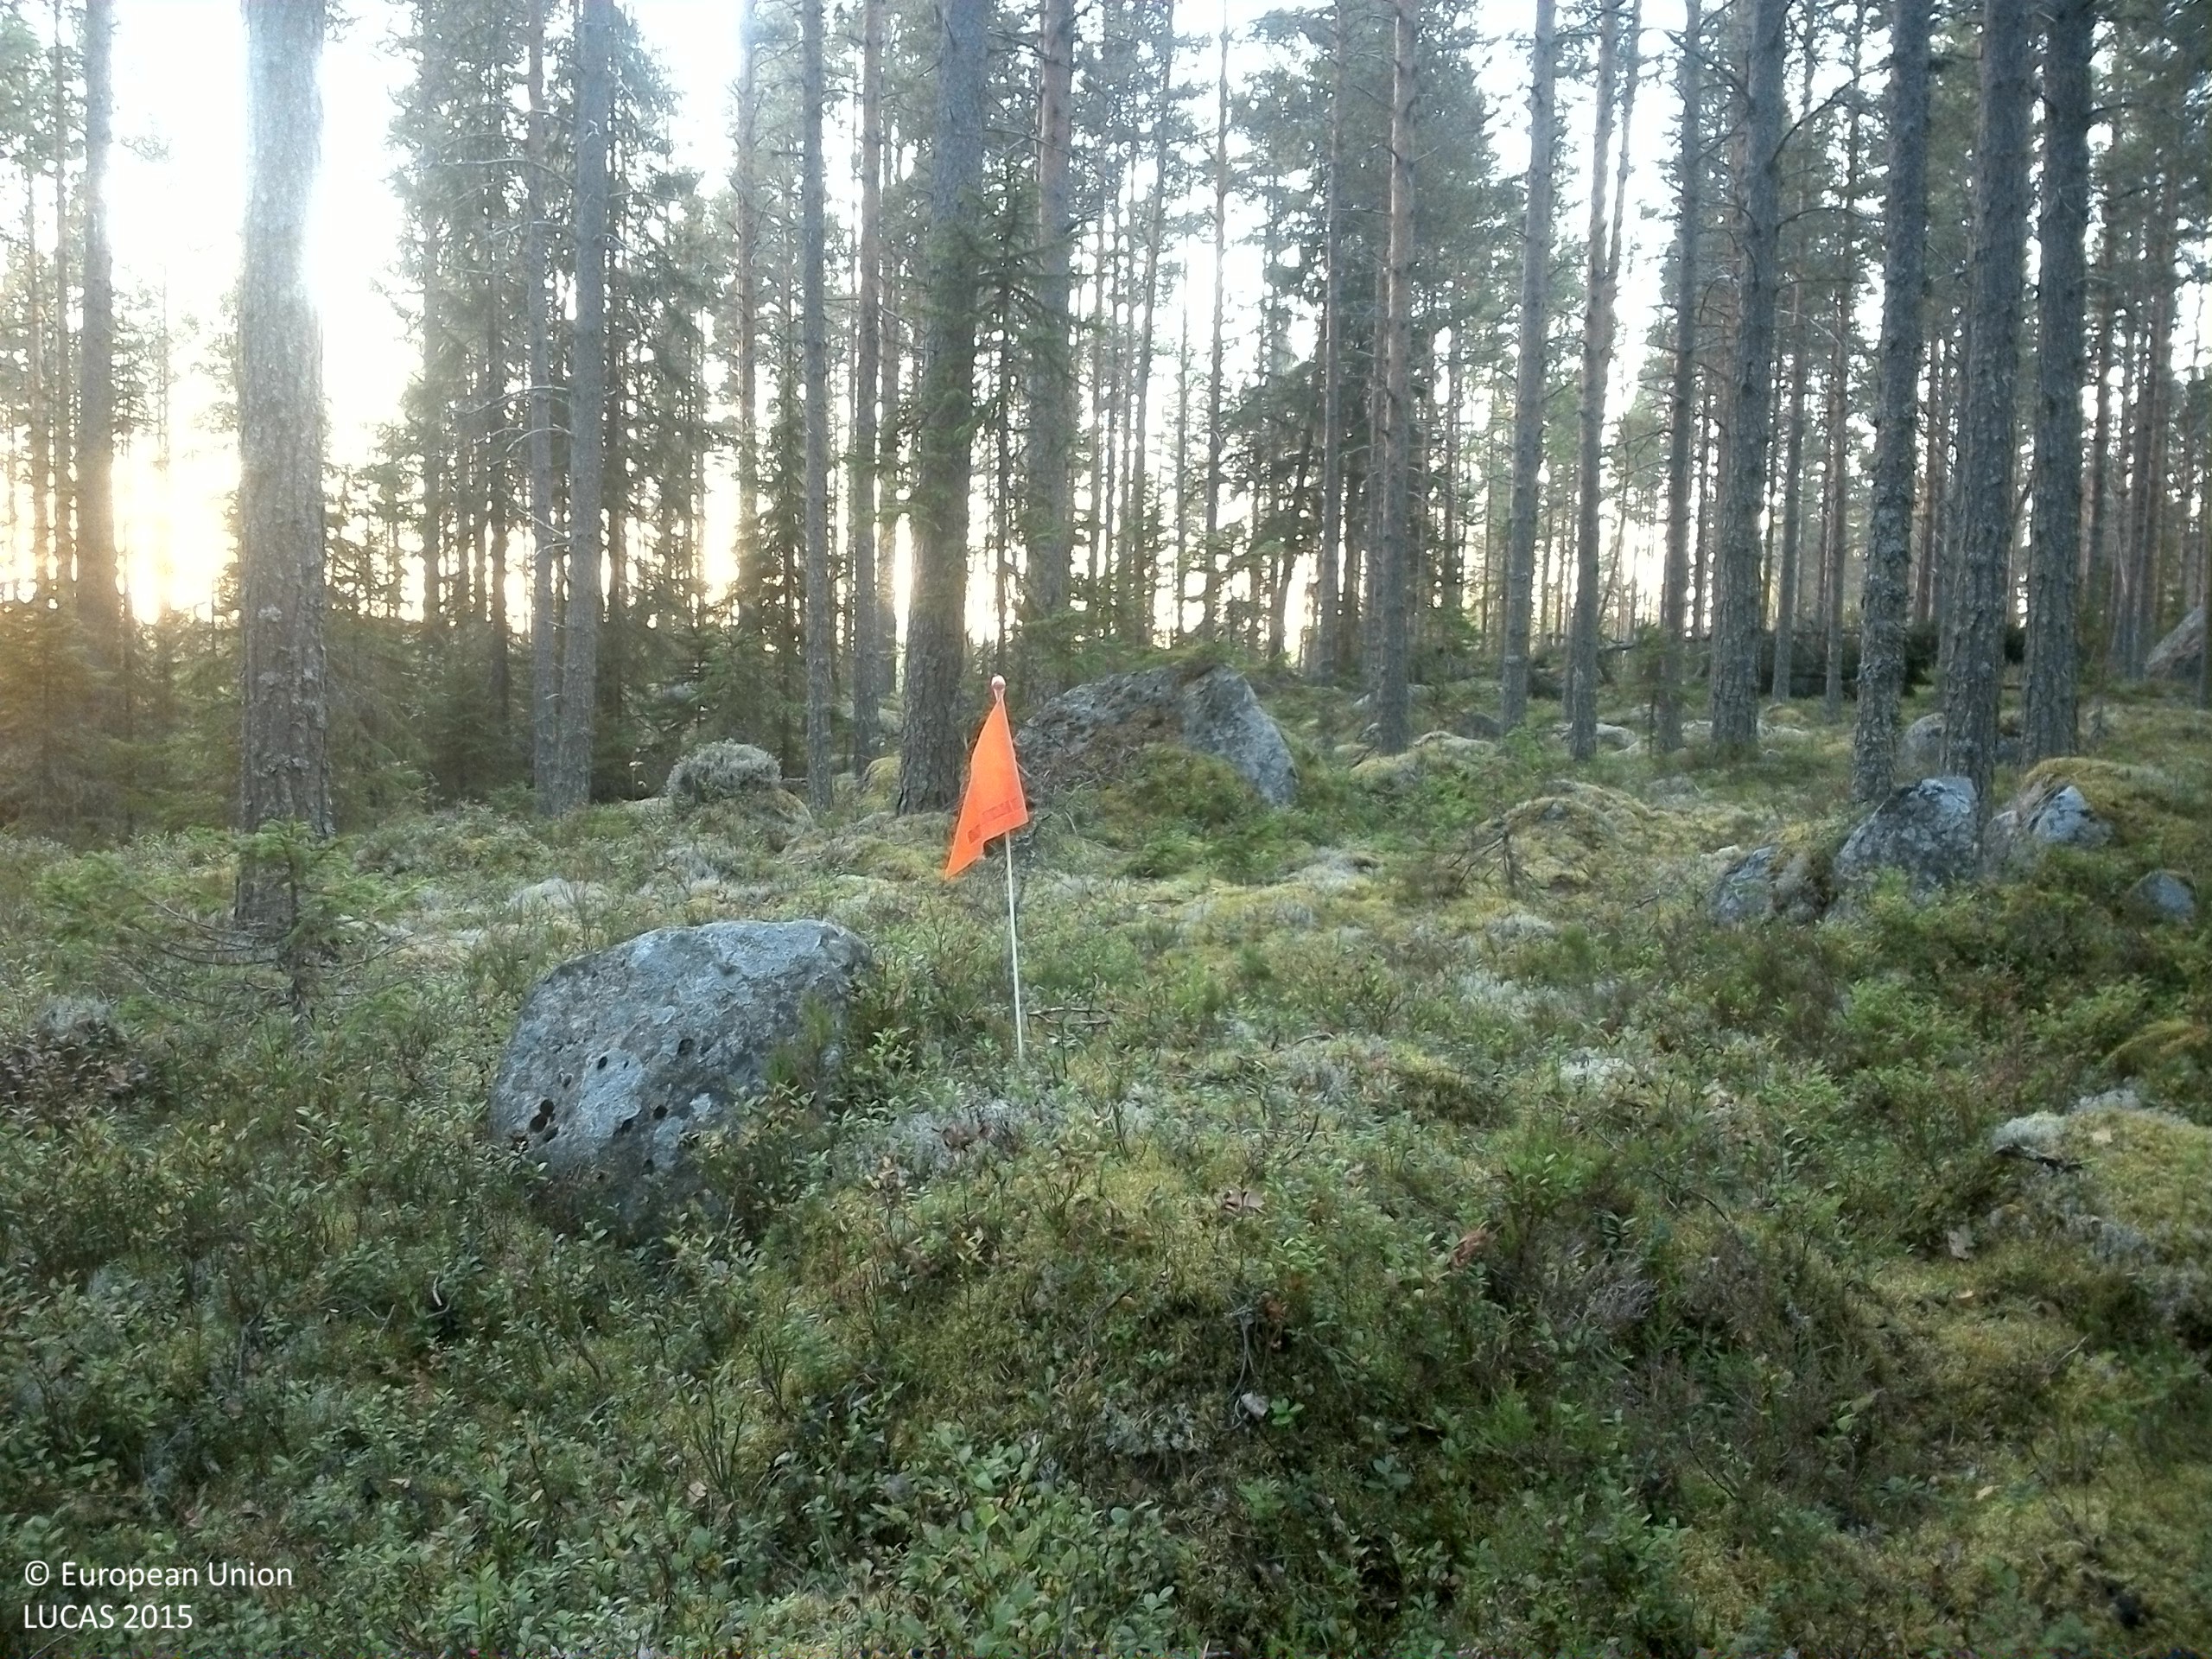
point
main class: Woodland
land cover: Pine dominated coniferous woodland
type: boreal forest
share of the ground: > 75 %
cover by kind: coniferous forest trees 75 %, shrubs 10 %, lichens and mosses 10 %, broadleaved forest trees 5 %
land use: Forestry
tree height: > 5 m
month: September
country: SE
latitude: 61.6288
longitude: 15.4354
